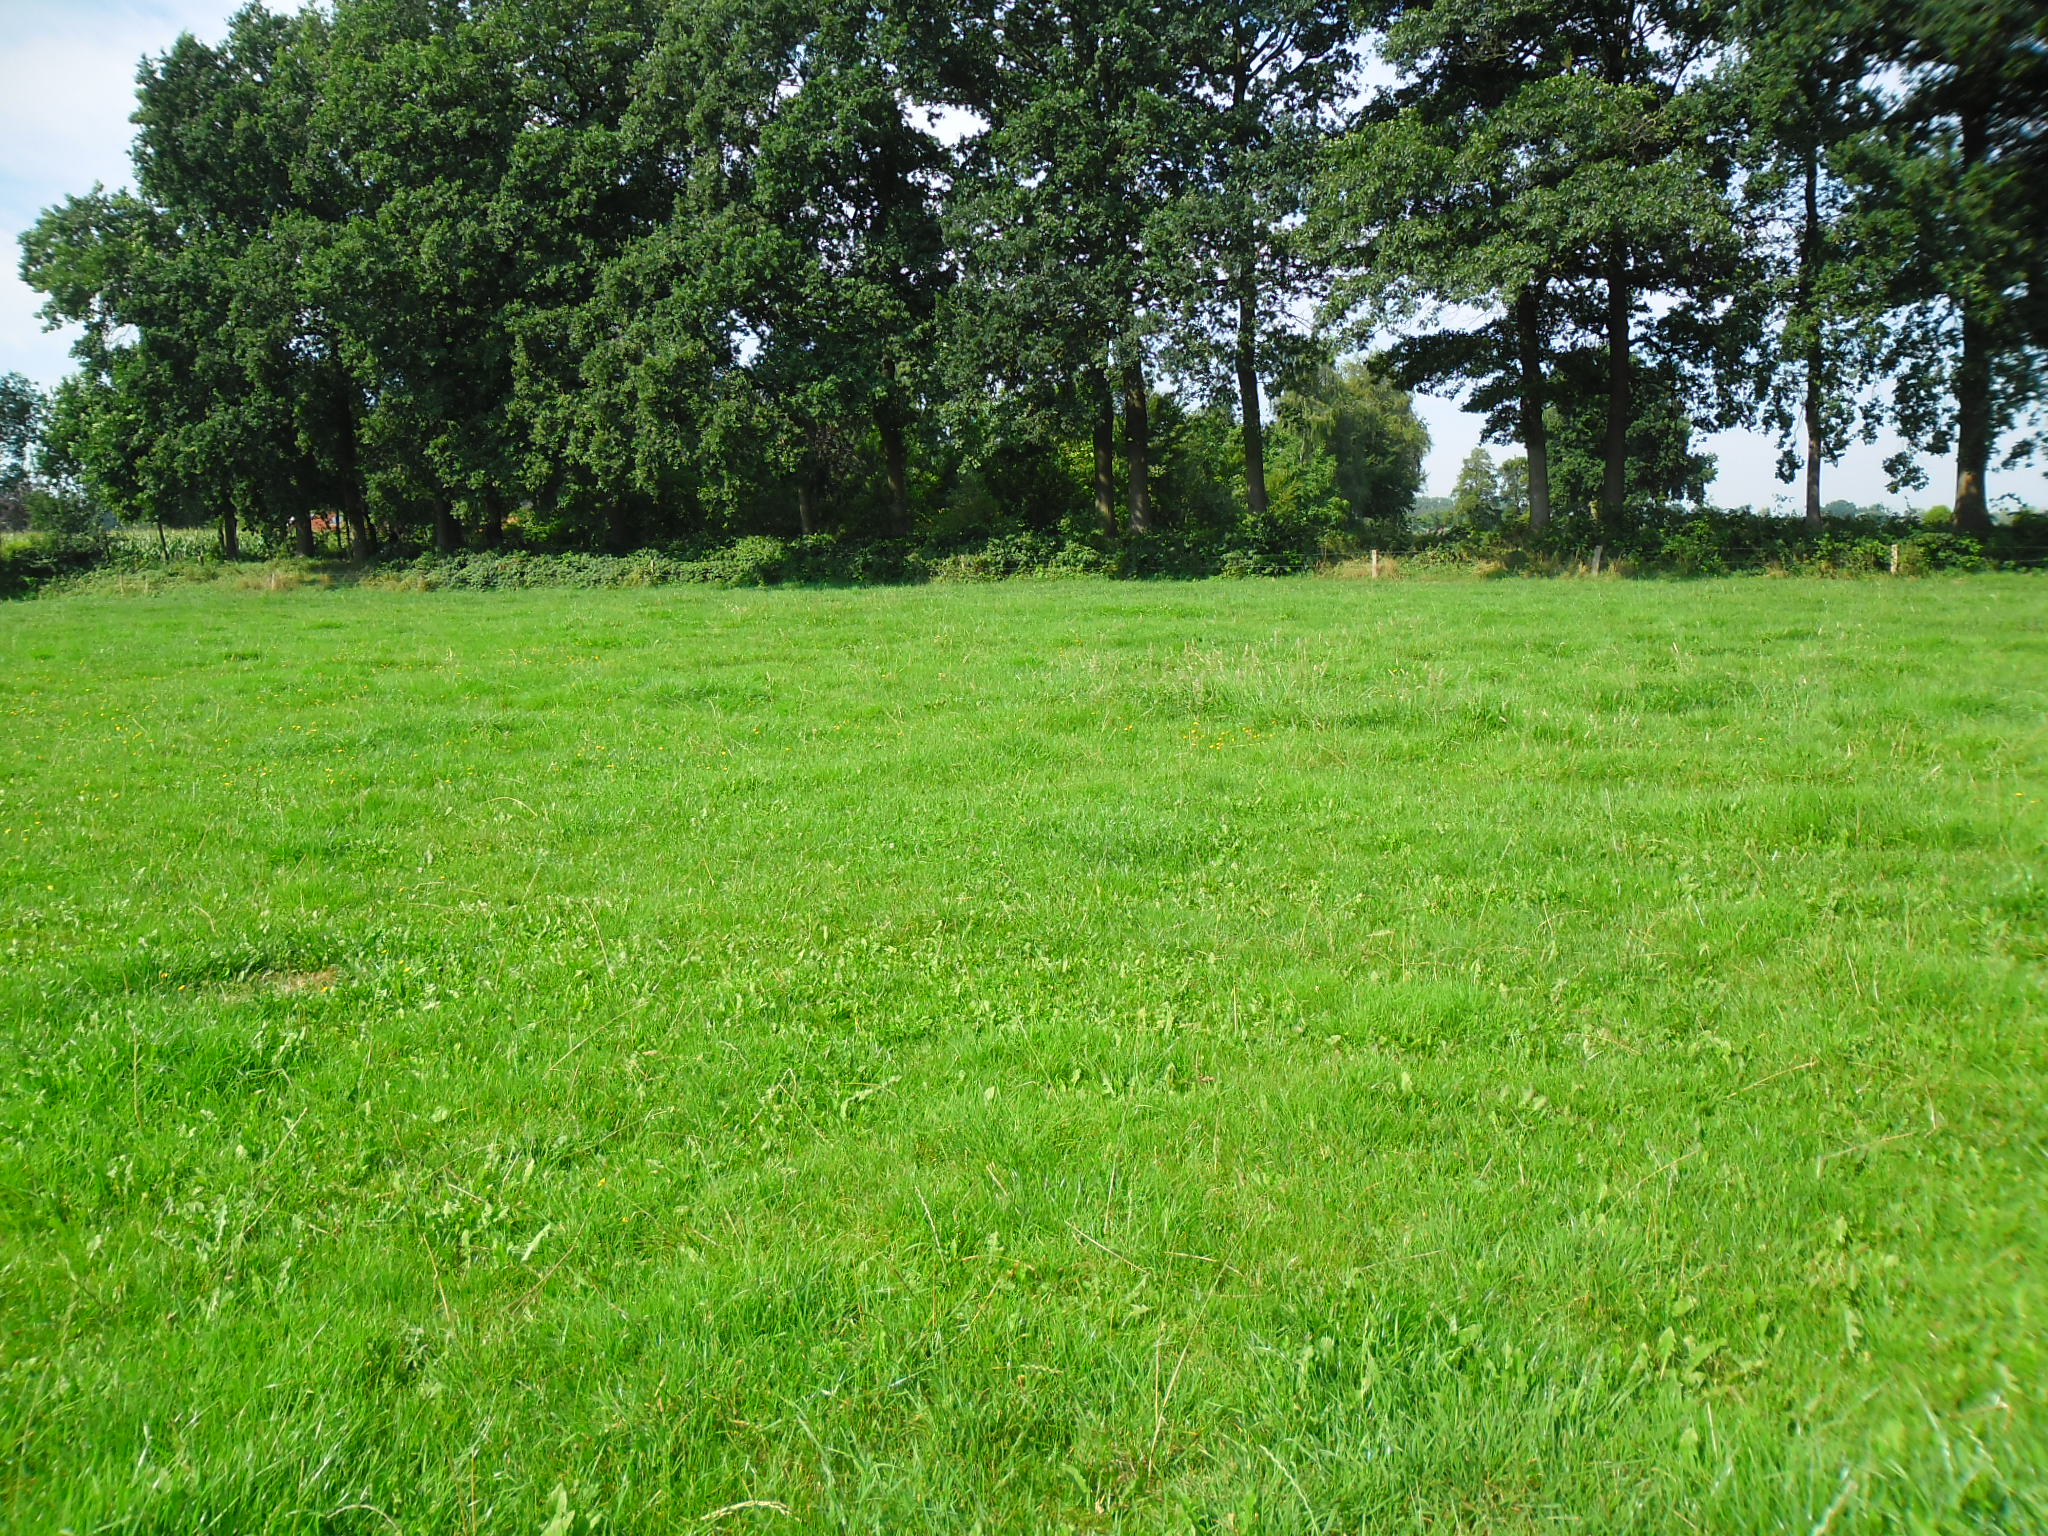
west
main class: Grassland
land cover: Grassland without tree/shrub cover
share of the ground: > 75 %
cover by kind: herbaceous plants 100 %
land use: Agriculture (excluding fallow land and kitchen gardens)
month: August
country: NL
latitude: 52.4603
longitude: 6.1876
